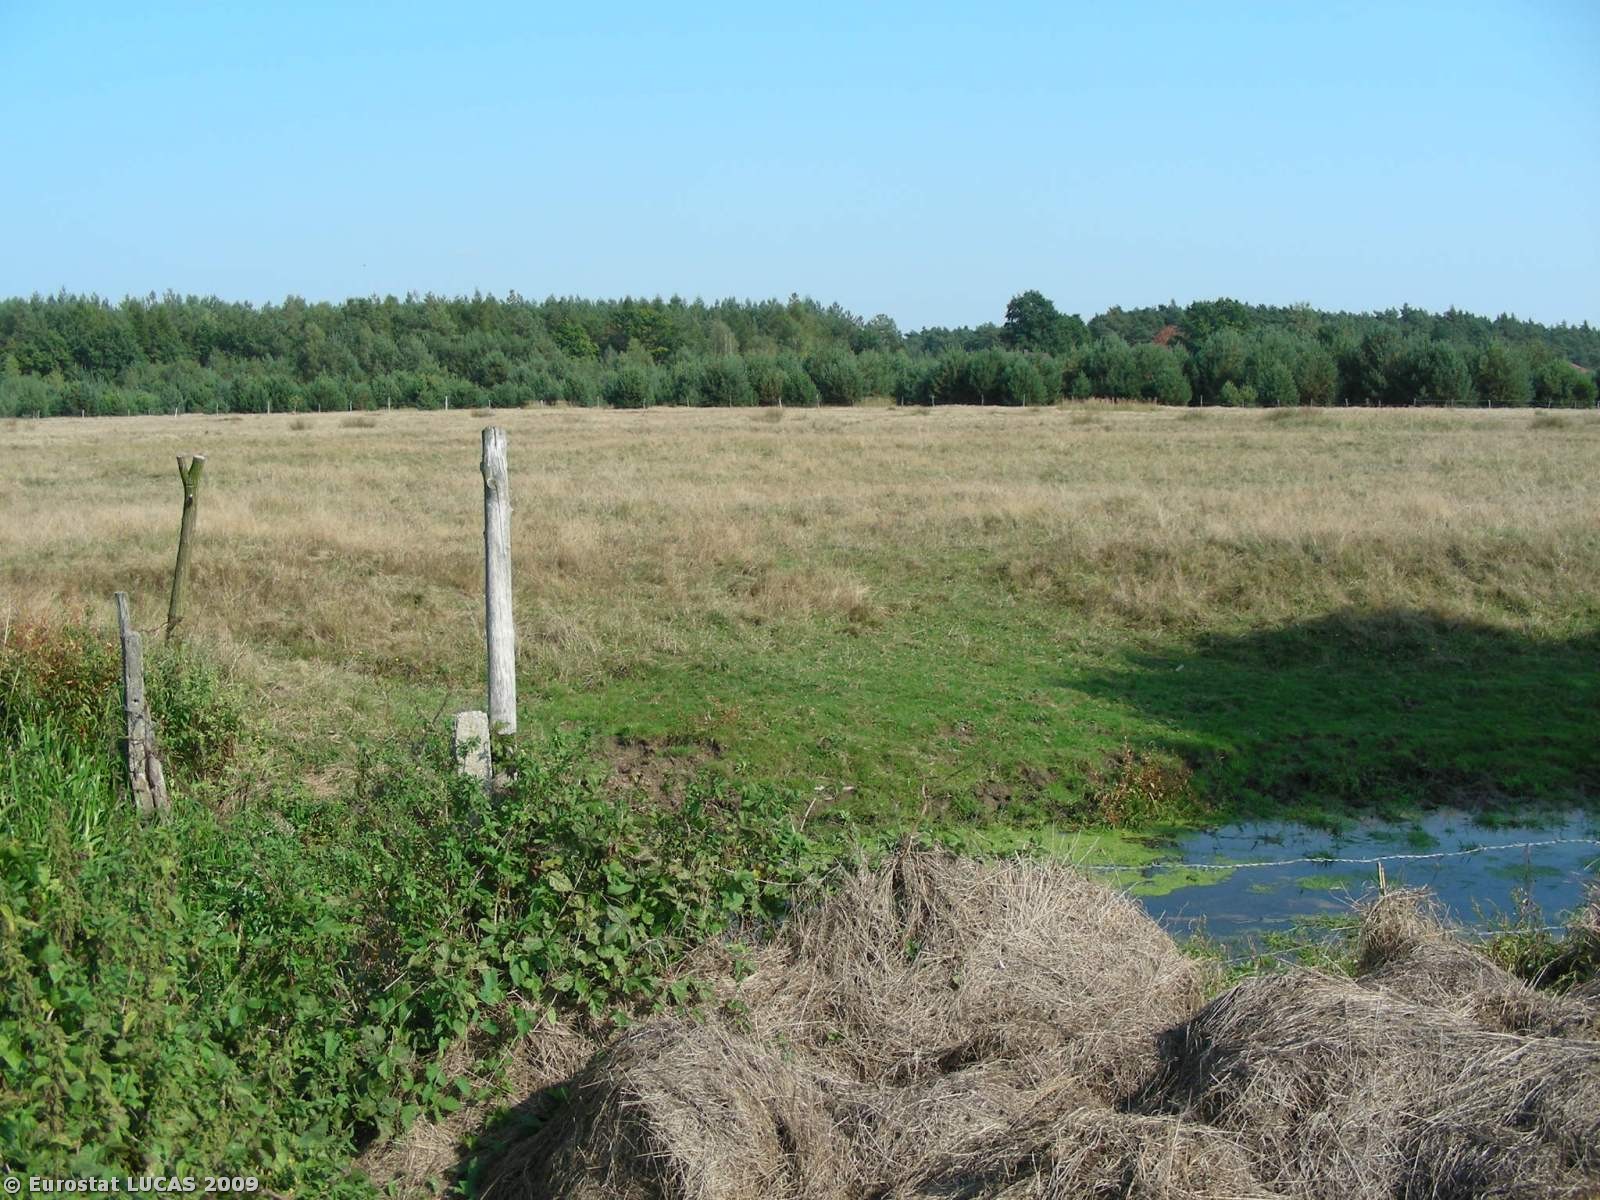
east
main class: Grassland
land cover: Grassland without tree/shrub cover
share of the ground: > 75 %
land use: Fallow land
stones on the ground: < 10 %
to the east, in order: Grassland without tree/shrub cover
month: September
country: PL
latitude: 50.3637
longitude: 22.1926
